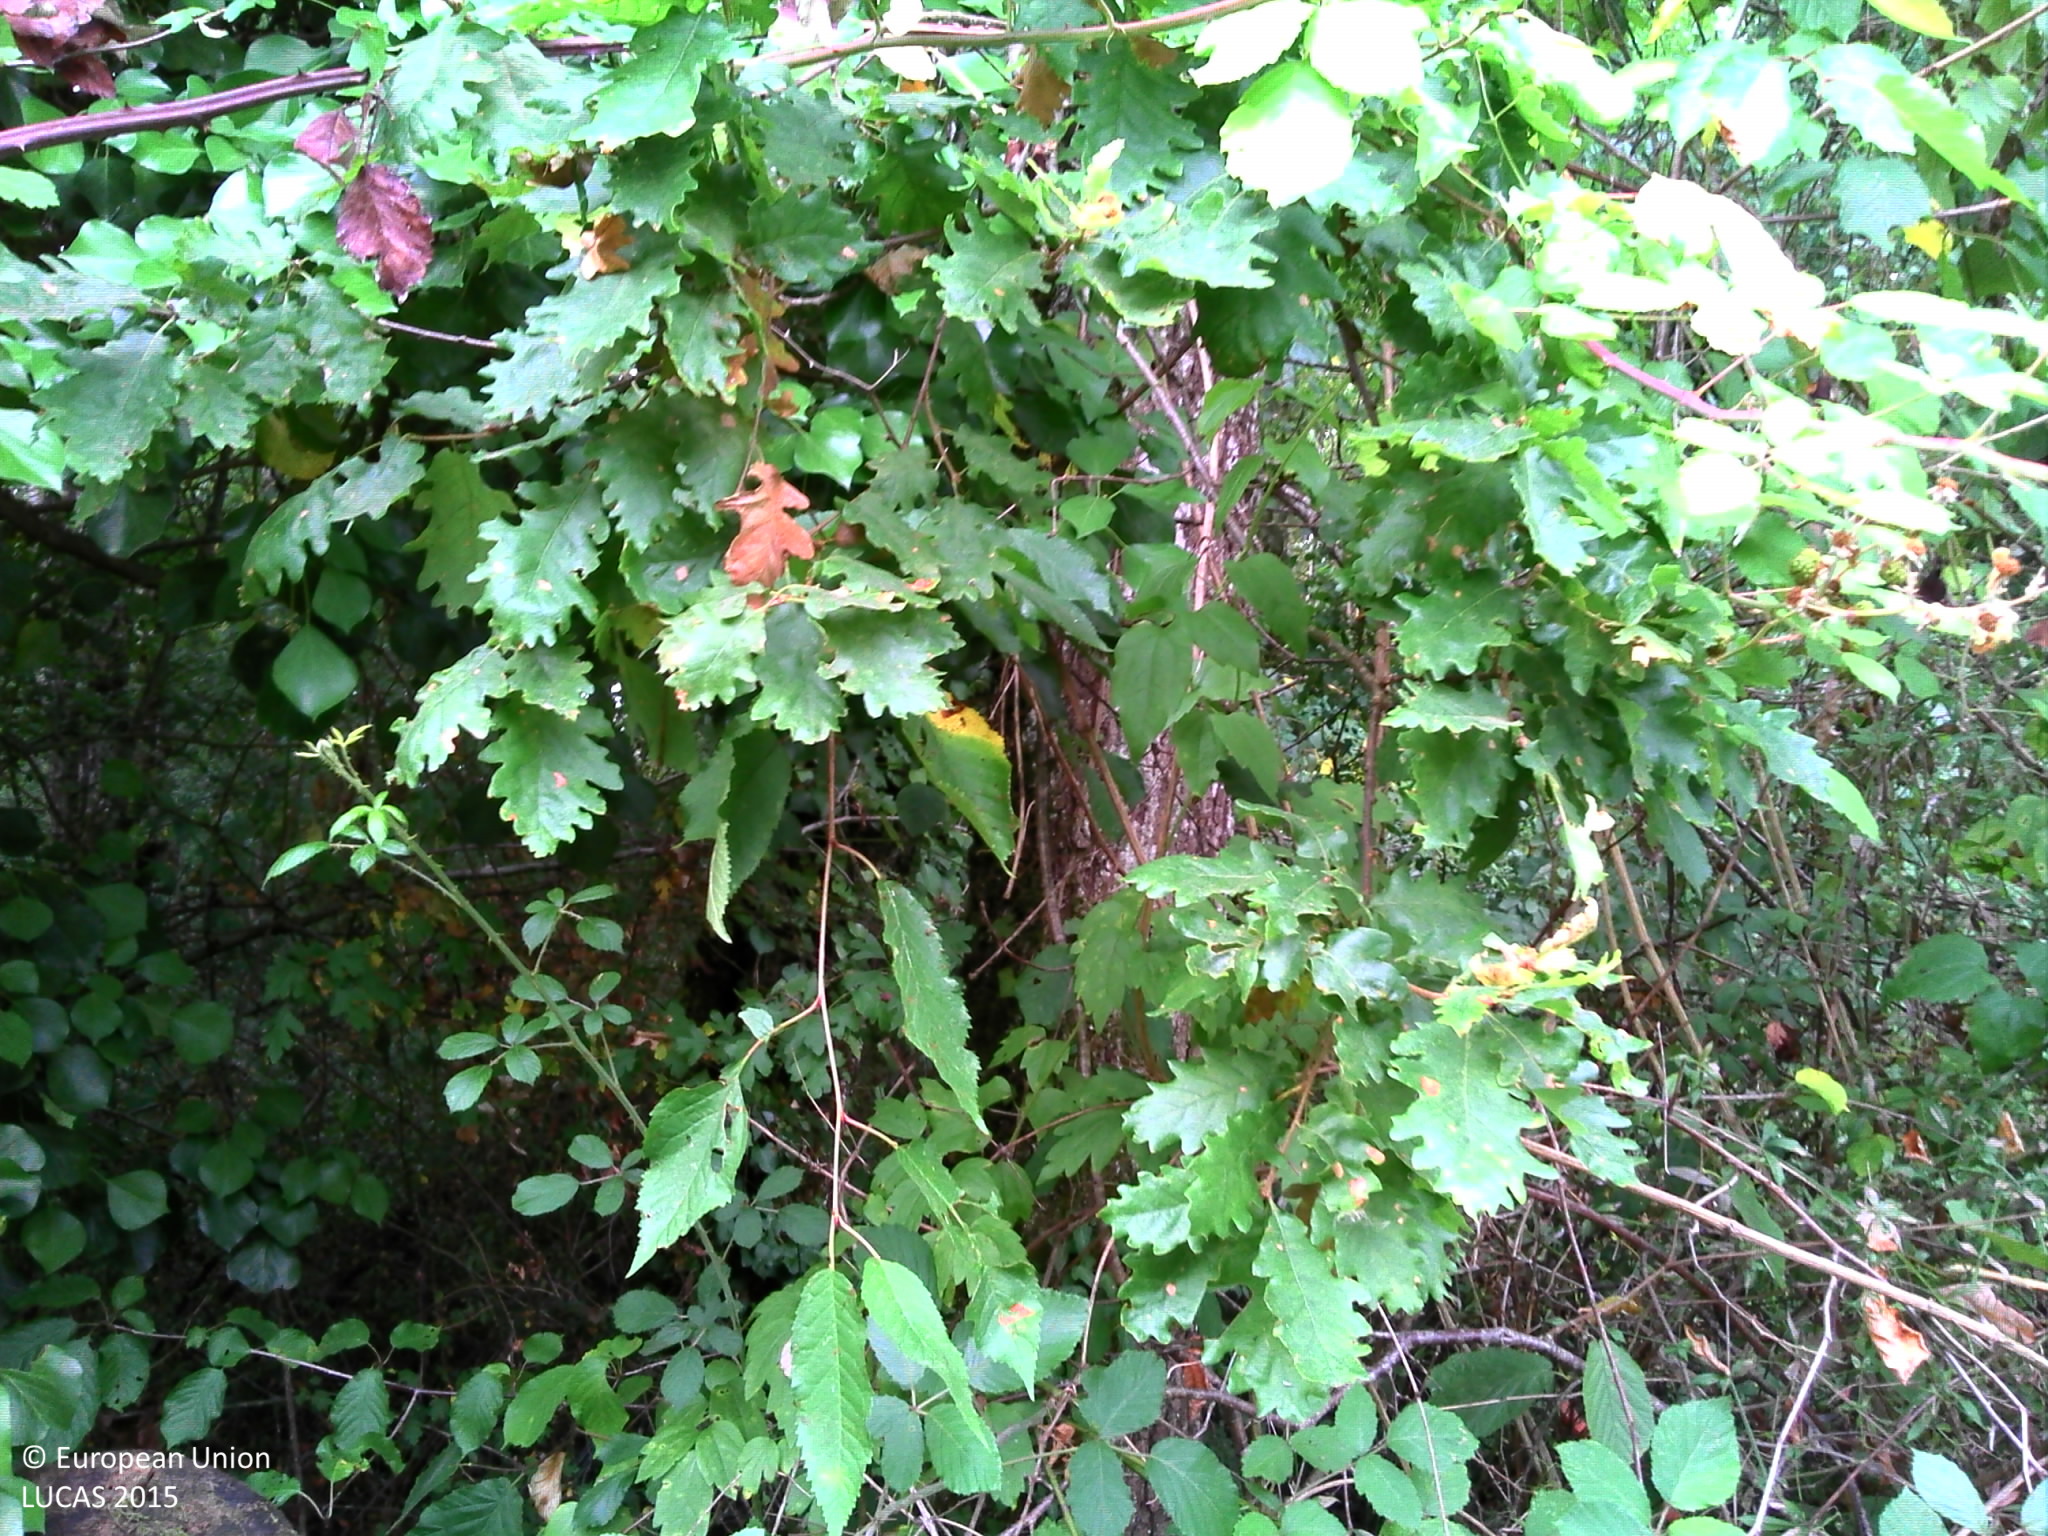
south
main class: Woodland
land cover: Broadleaved woodland
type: thermophilous deciduous forest
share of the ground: > 75 %
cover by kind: broadleaved forest trees 80 %, herbaceous plants 10 %, shrubs 5 %, lichens and mosses 5 %
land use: Residential
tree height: > 5 m
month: July
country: FR
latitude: 44.9570
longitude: 0.8014
